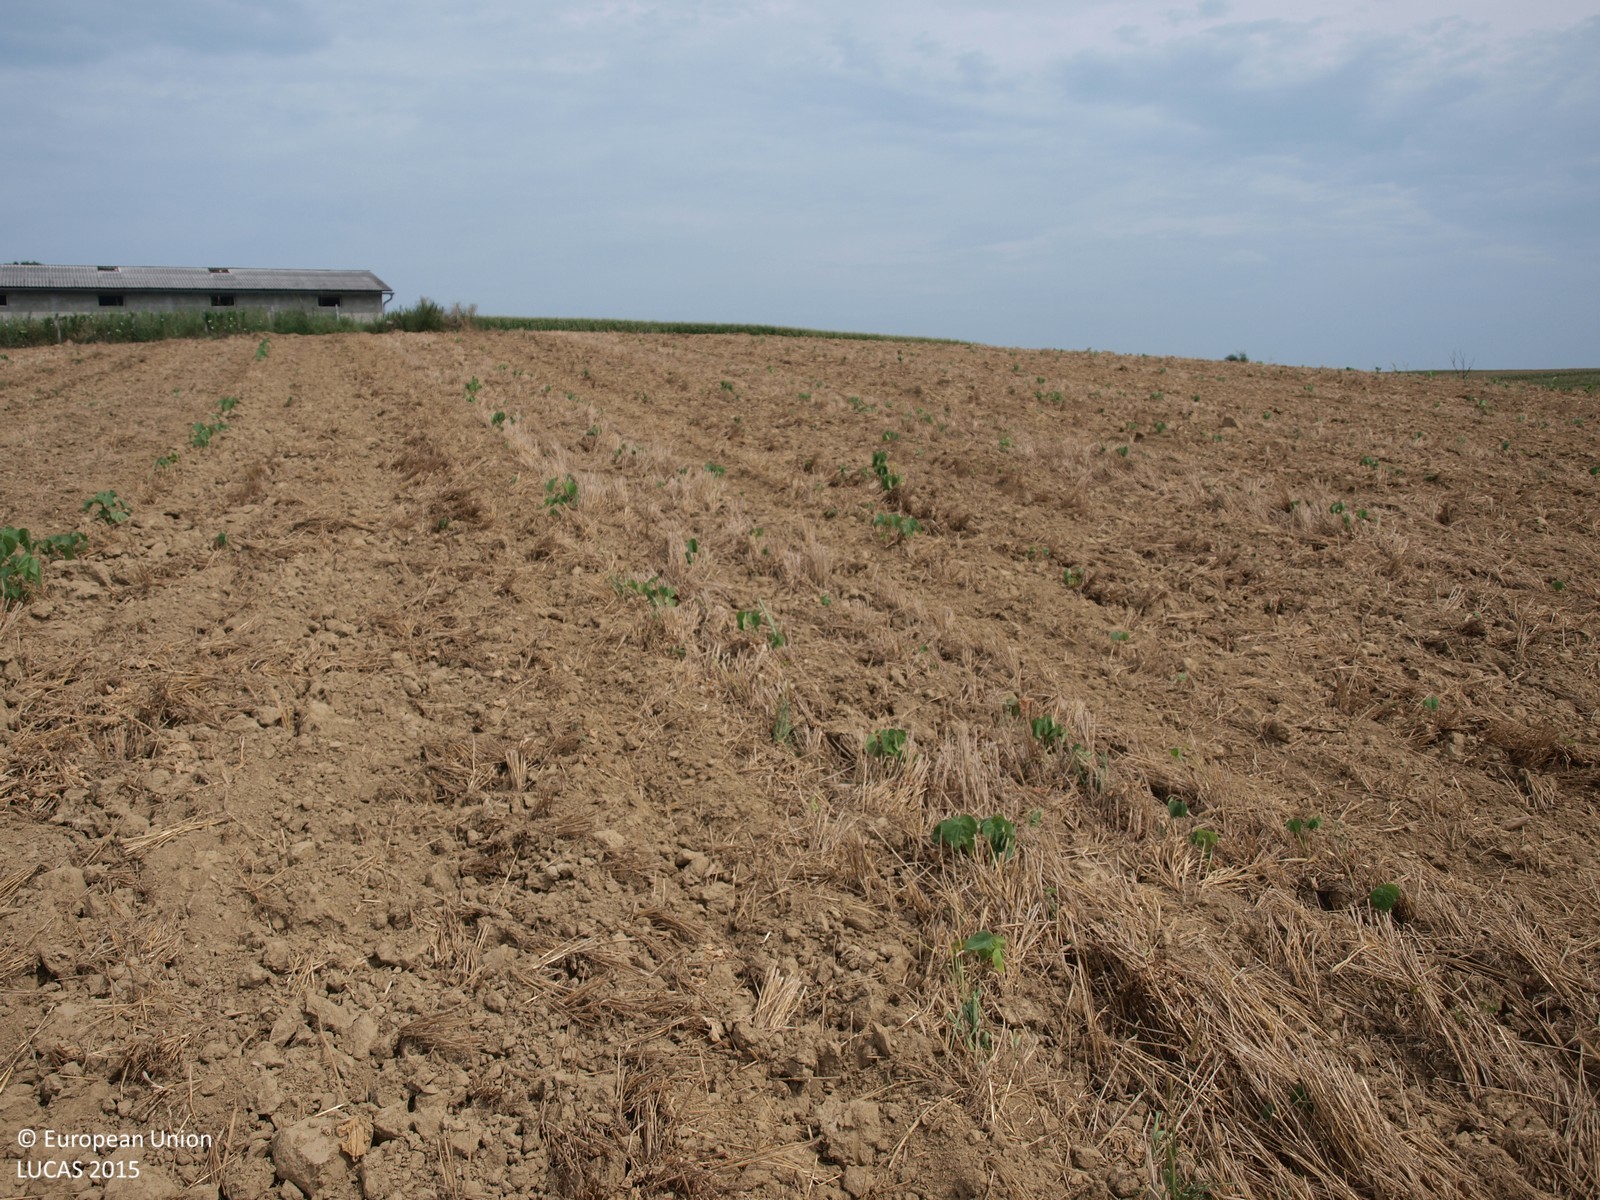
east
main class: Cropland
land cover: Barley
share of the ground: > 75 %
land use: Agriculture (excluding fallow land and kitchen gardens)
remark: Harvested field
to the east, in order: Barley; Maize; Grass margins; Maize
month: August
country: HR
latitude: 46.0513
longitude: 16.3971
